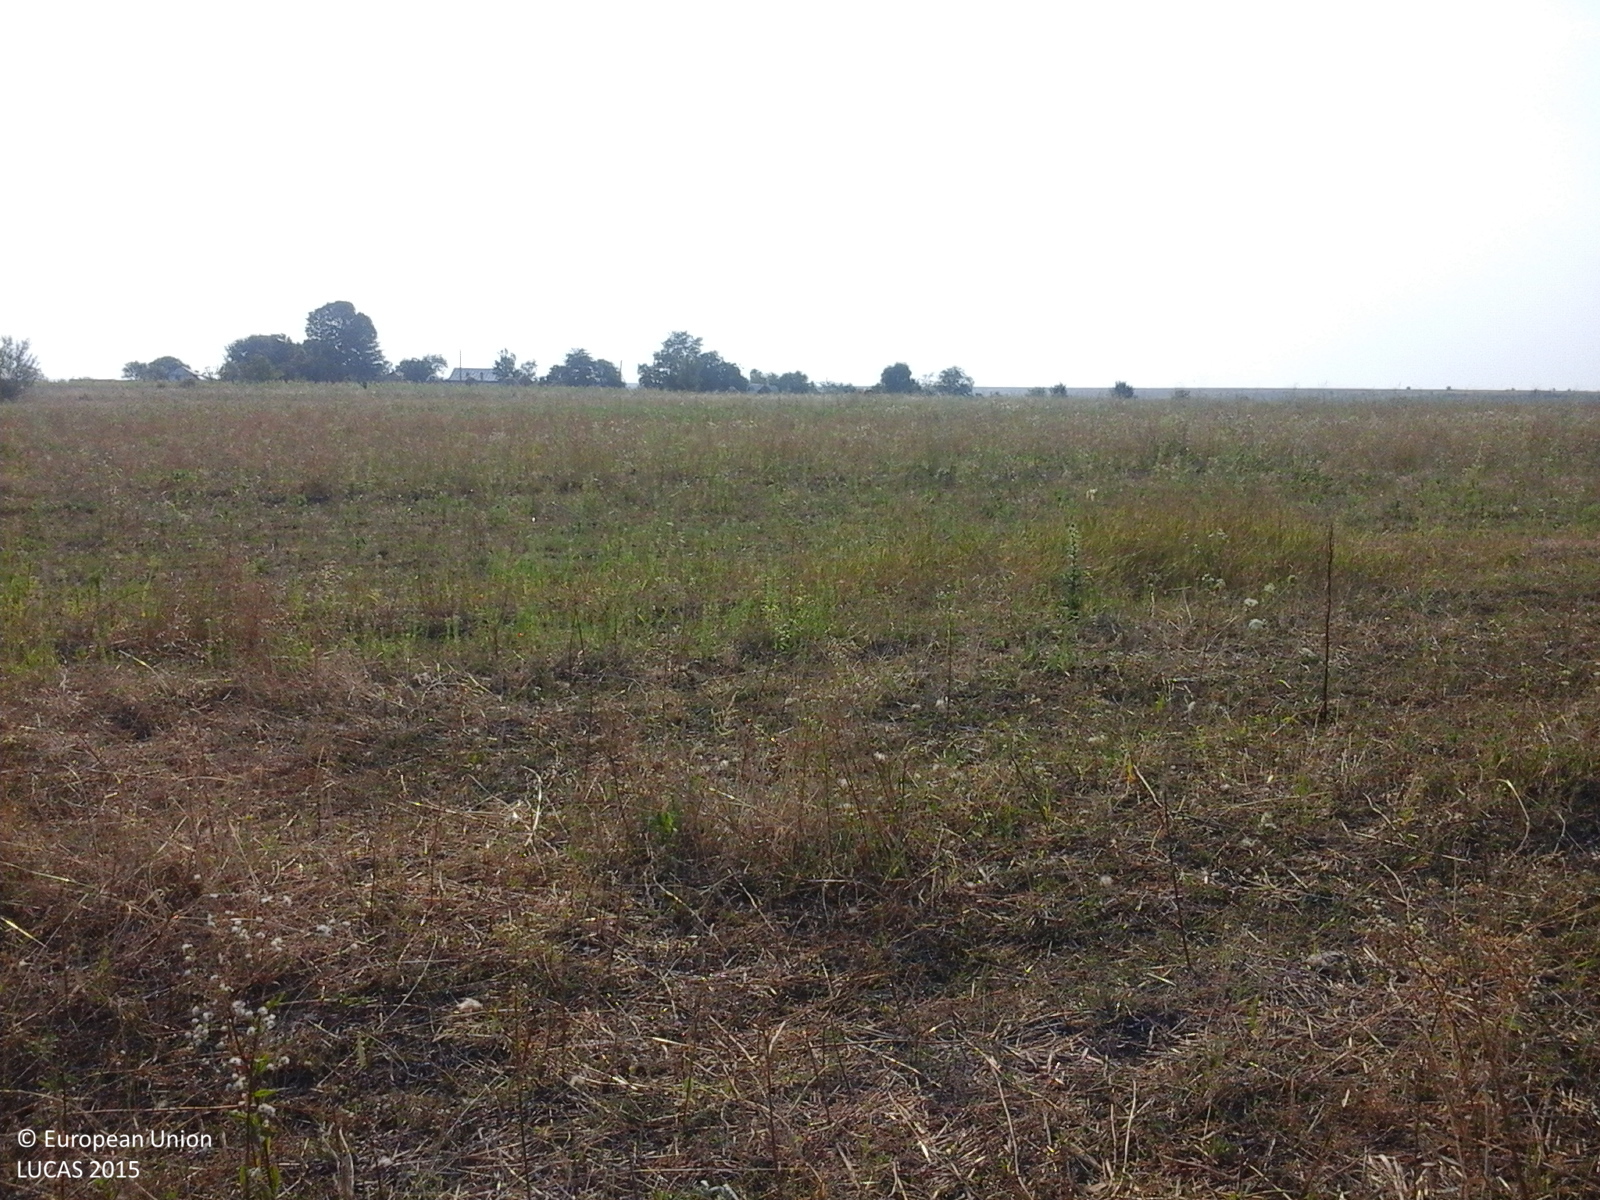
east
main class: Grassland
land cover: Grassland without tree/shrub cover
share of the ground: > 75 %
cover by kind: herbaceous plants 100 %
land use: Agriculture (excluding fallow land and kitchen gardens)
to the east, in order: Grassland without tree/shrub cover; Common wheat; Lucerne; Spontaneously vegetated surfaces; Lucerne; Maize; Single bushes/trees; Tomatoes; Nuts trees
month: August
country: RO
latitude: 44.4775
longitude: 23.2882
